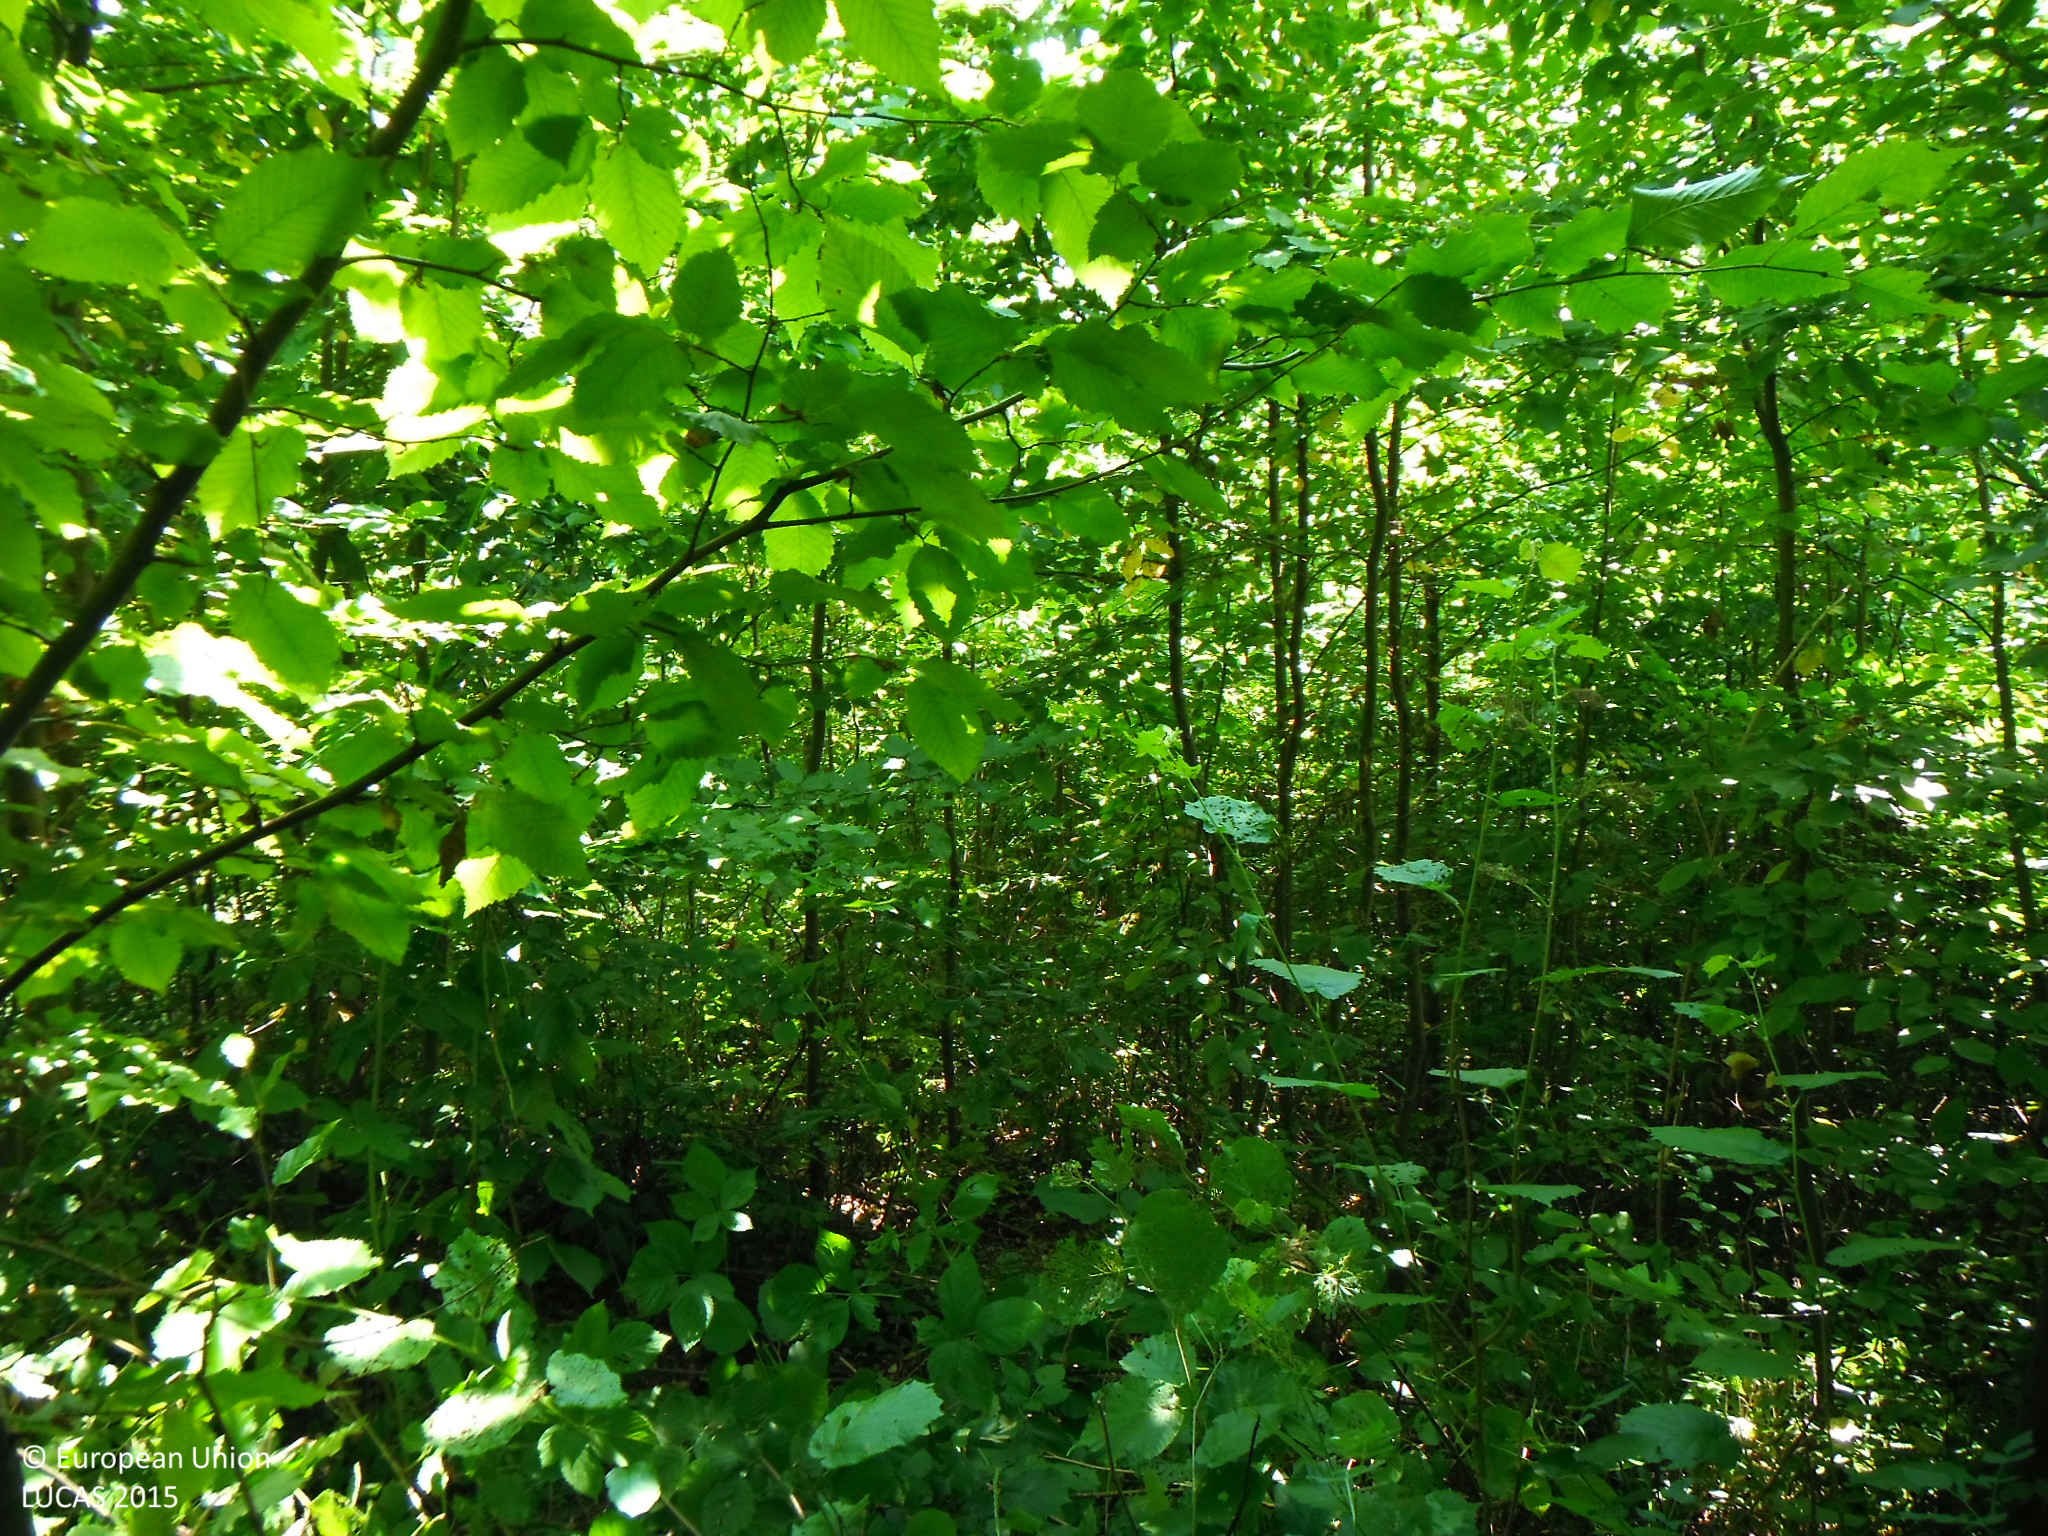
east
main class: Woodland
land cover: Broadleaved woodland
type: beech forest
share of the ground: > 75 %
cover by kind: broadleaved forest trees 100 %
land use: Forestry
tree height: < 5 m
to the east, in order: Broadleaved woodland; Ditches and canals; Broadleaved woodland; Spruce dominated mixed woodland; Broadleaved woodland; Tracks; Broadleaved woodland
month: July
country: SK
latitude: 49.1419
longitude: 21.8841
